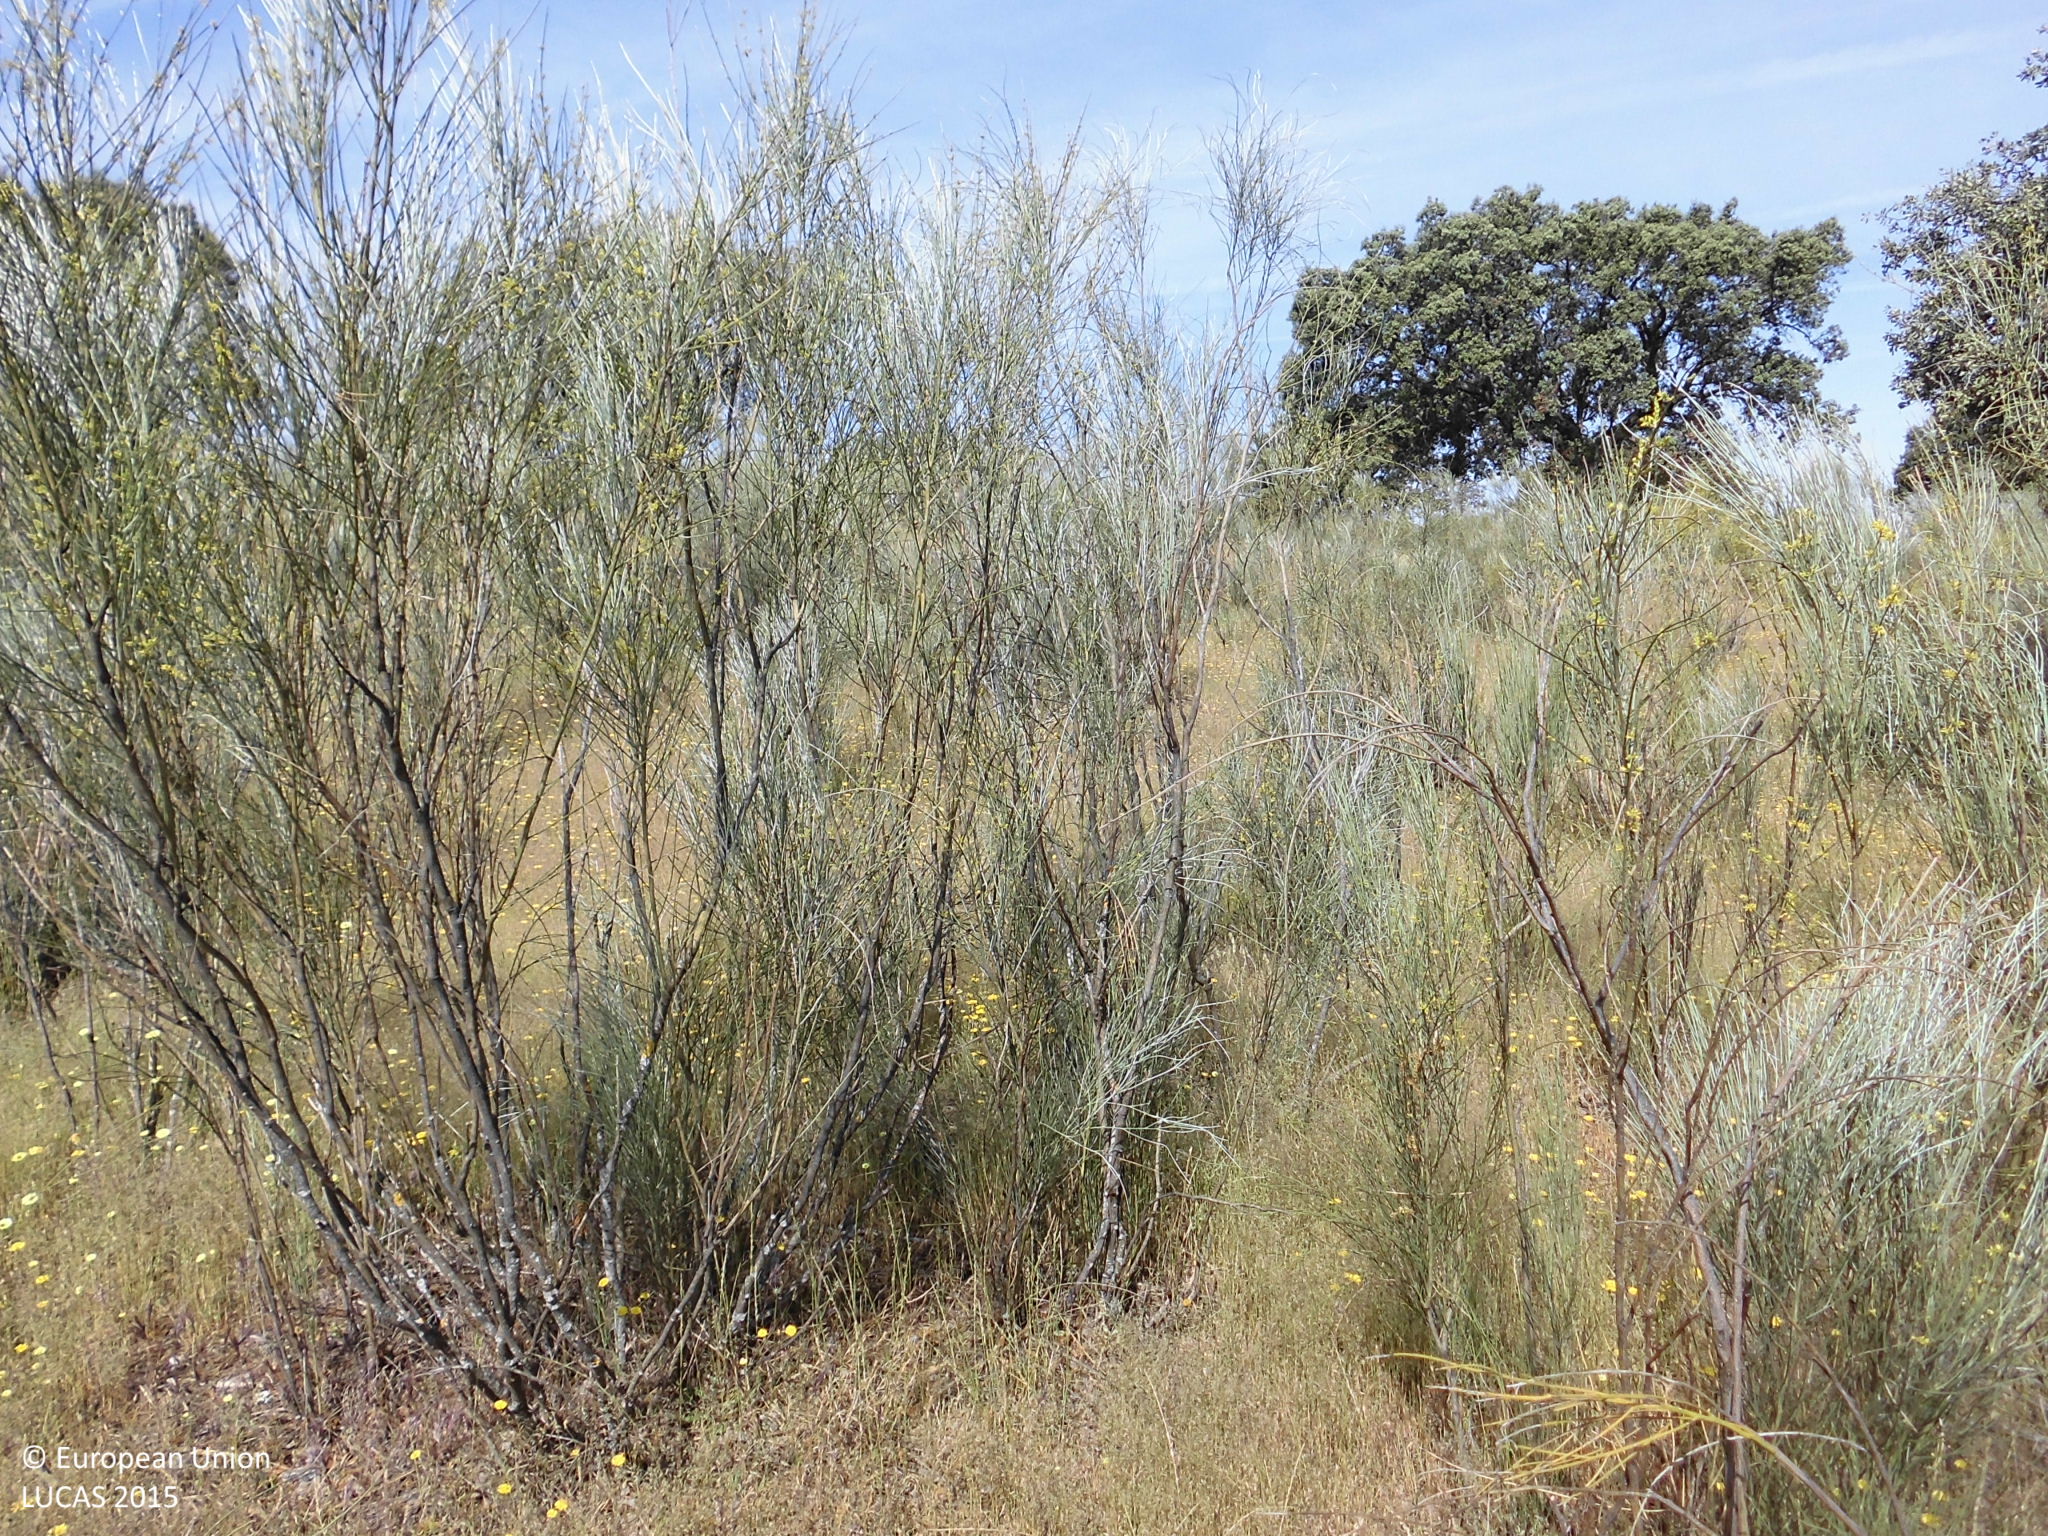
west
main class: Woodland
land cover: Broadleaved woodland
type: broadleaved evergreen forest
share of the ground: 10 - 25 %
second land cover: Grassland without tree/shrub cover
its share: > 75 %
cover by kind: herbaceous plants 55 %, shrubs 25 %, broadleaved forest trees 20 %
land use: Forestry
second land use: Agriculture (excluding fallow land and kitchen gardens)
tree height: > 5 m
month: May
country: ES
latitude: 39.5571
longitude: -7.0409
